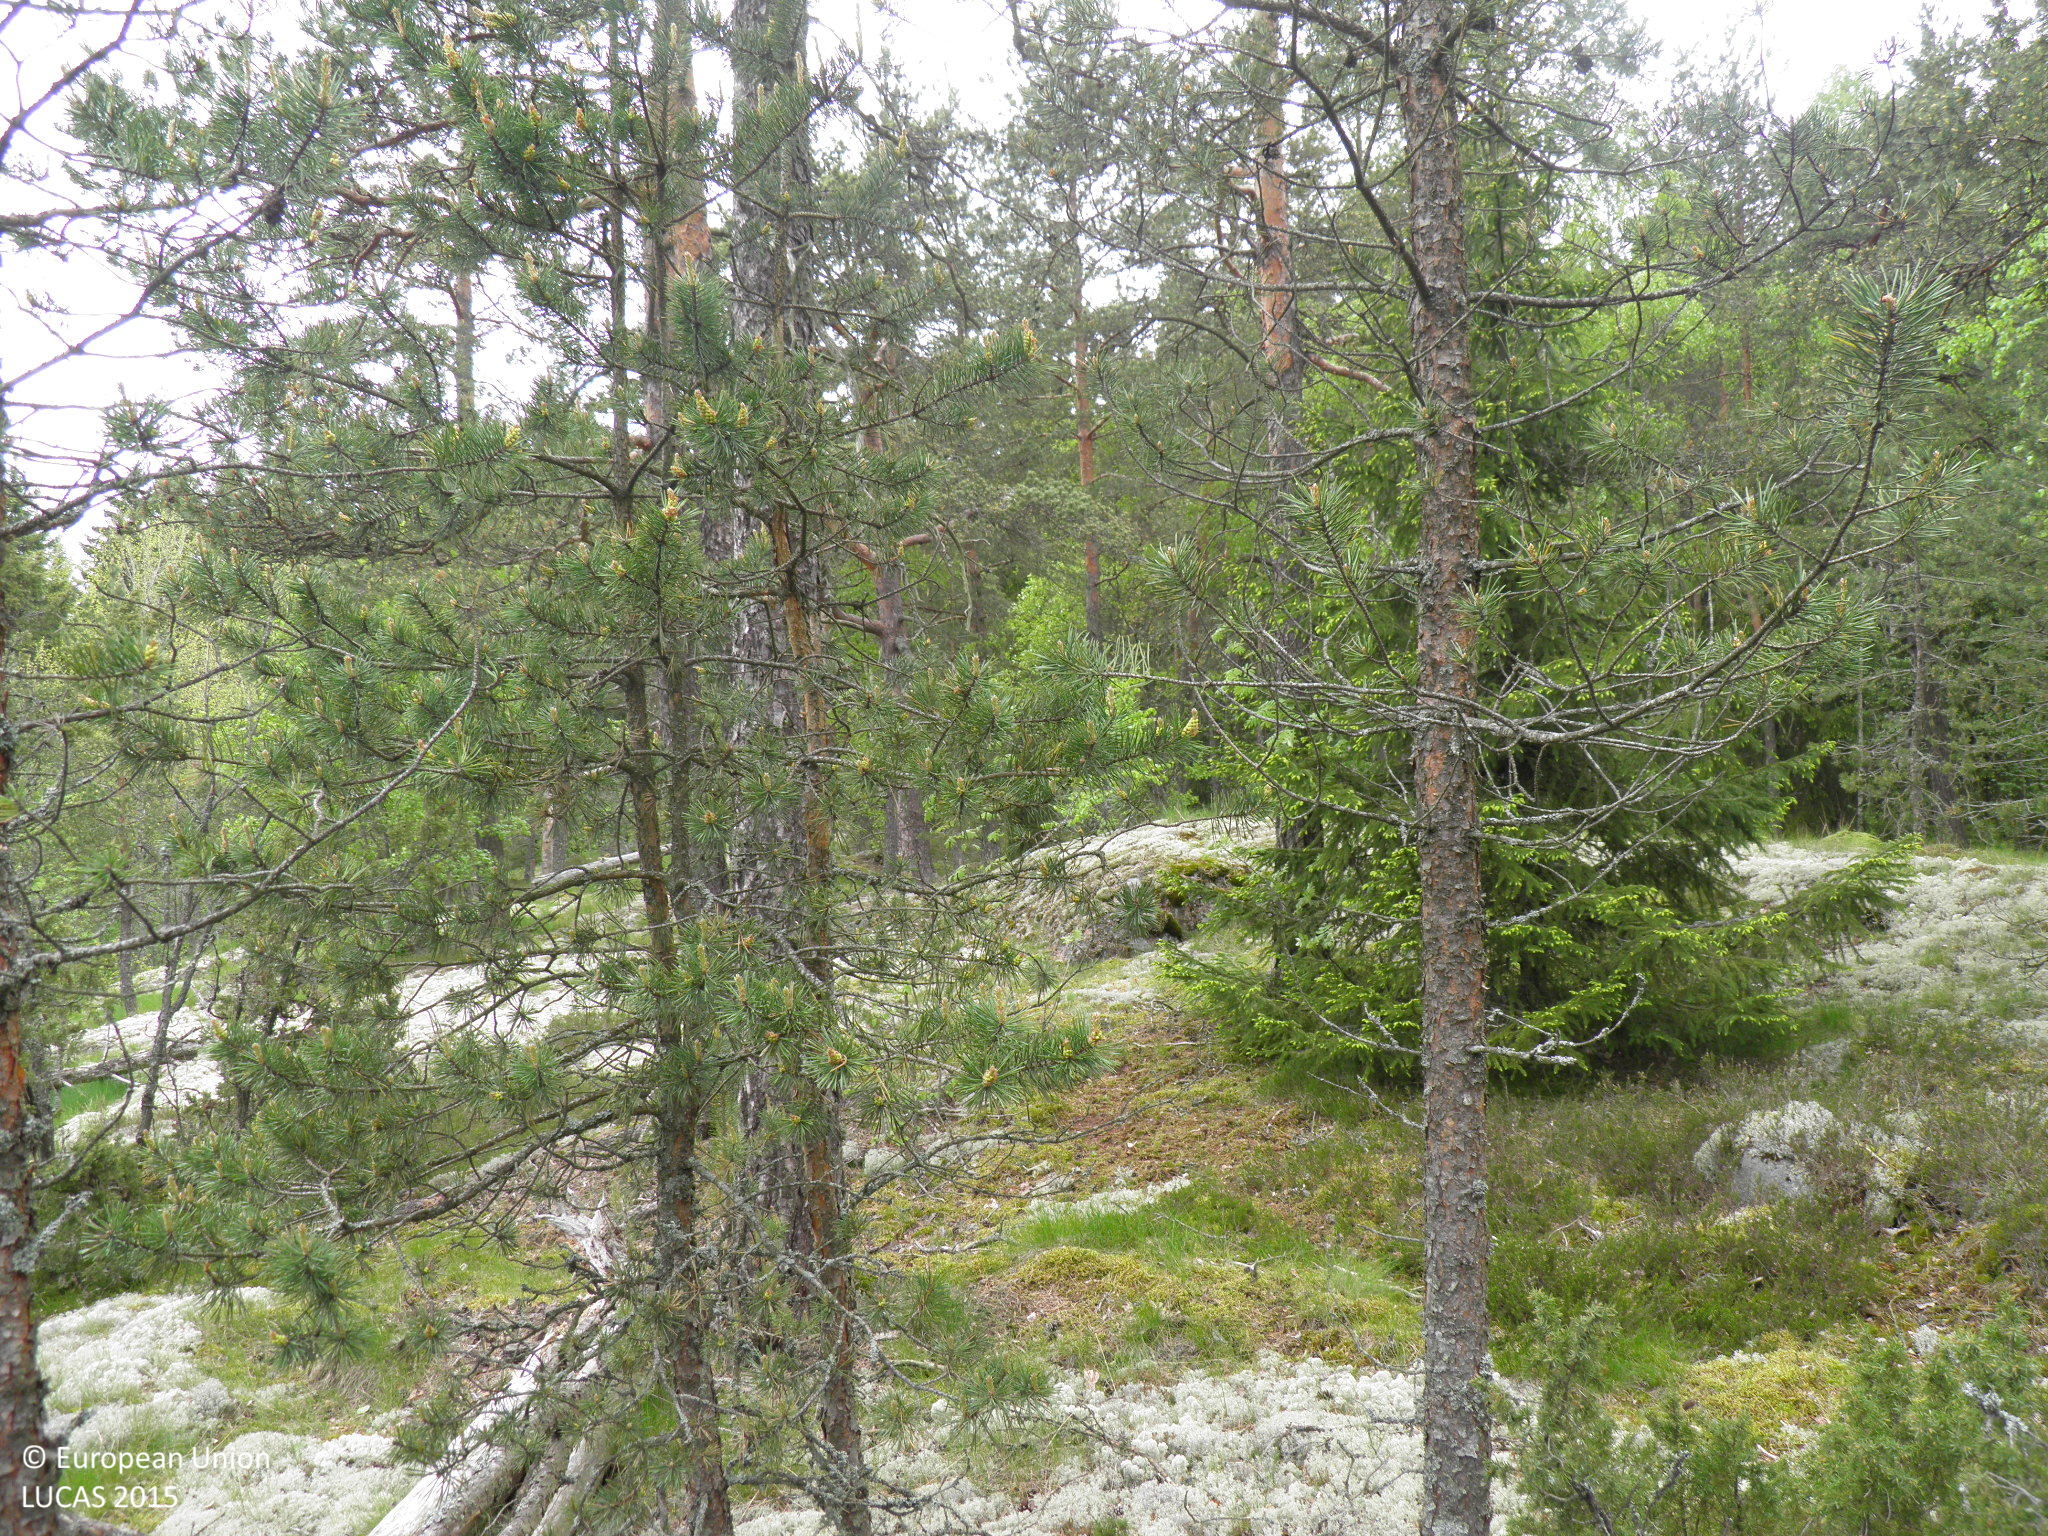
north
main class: Woodland
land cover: Pine dominated coniferous woodland
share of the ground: > 75 %
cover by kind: coniferous forest trees 80 %, broadleaved forest trees 10 %, shrubs 5 %, herbaceous plants 5 %
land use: Forestry
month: June
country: FI
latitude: 60.5108
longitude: 22.3609
